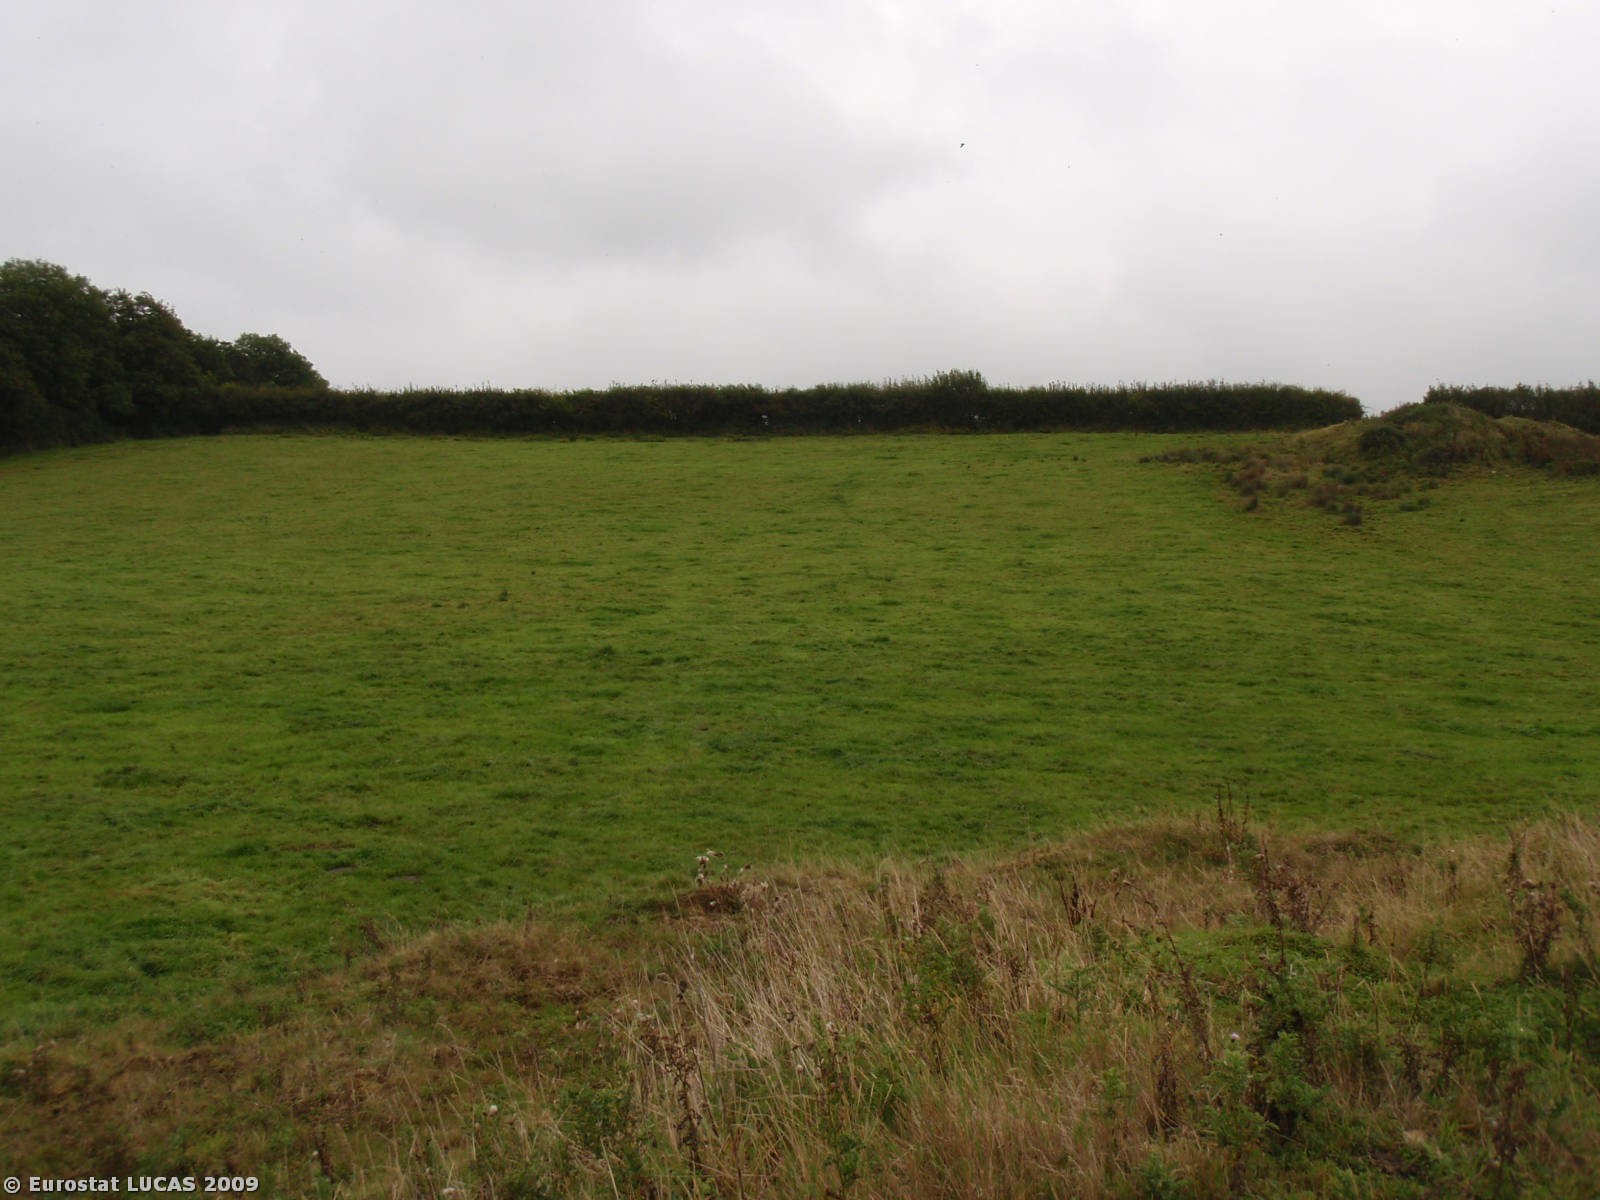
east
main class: Cropland
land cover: Maize
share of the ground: > 75 %
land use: Agriculture (excluding fallow land and kitchen gardens)
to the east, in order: Maize; Fences; Grass margins; Abandoned hedges; Grassland without tree/shrub cover
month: September
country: GB
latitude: 50.8784
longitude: -2.6467
